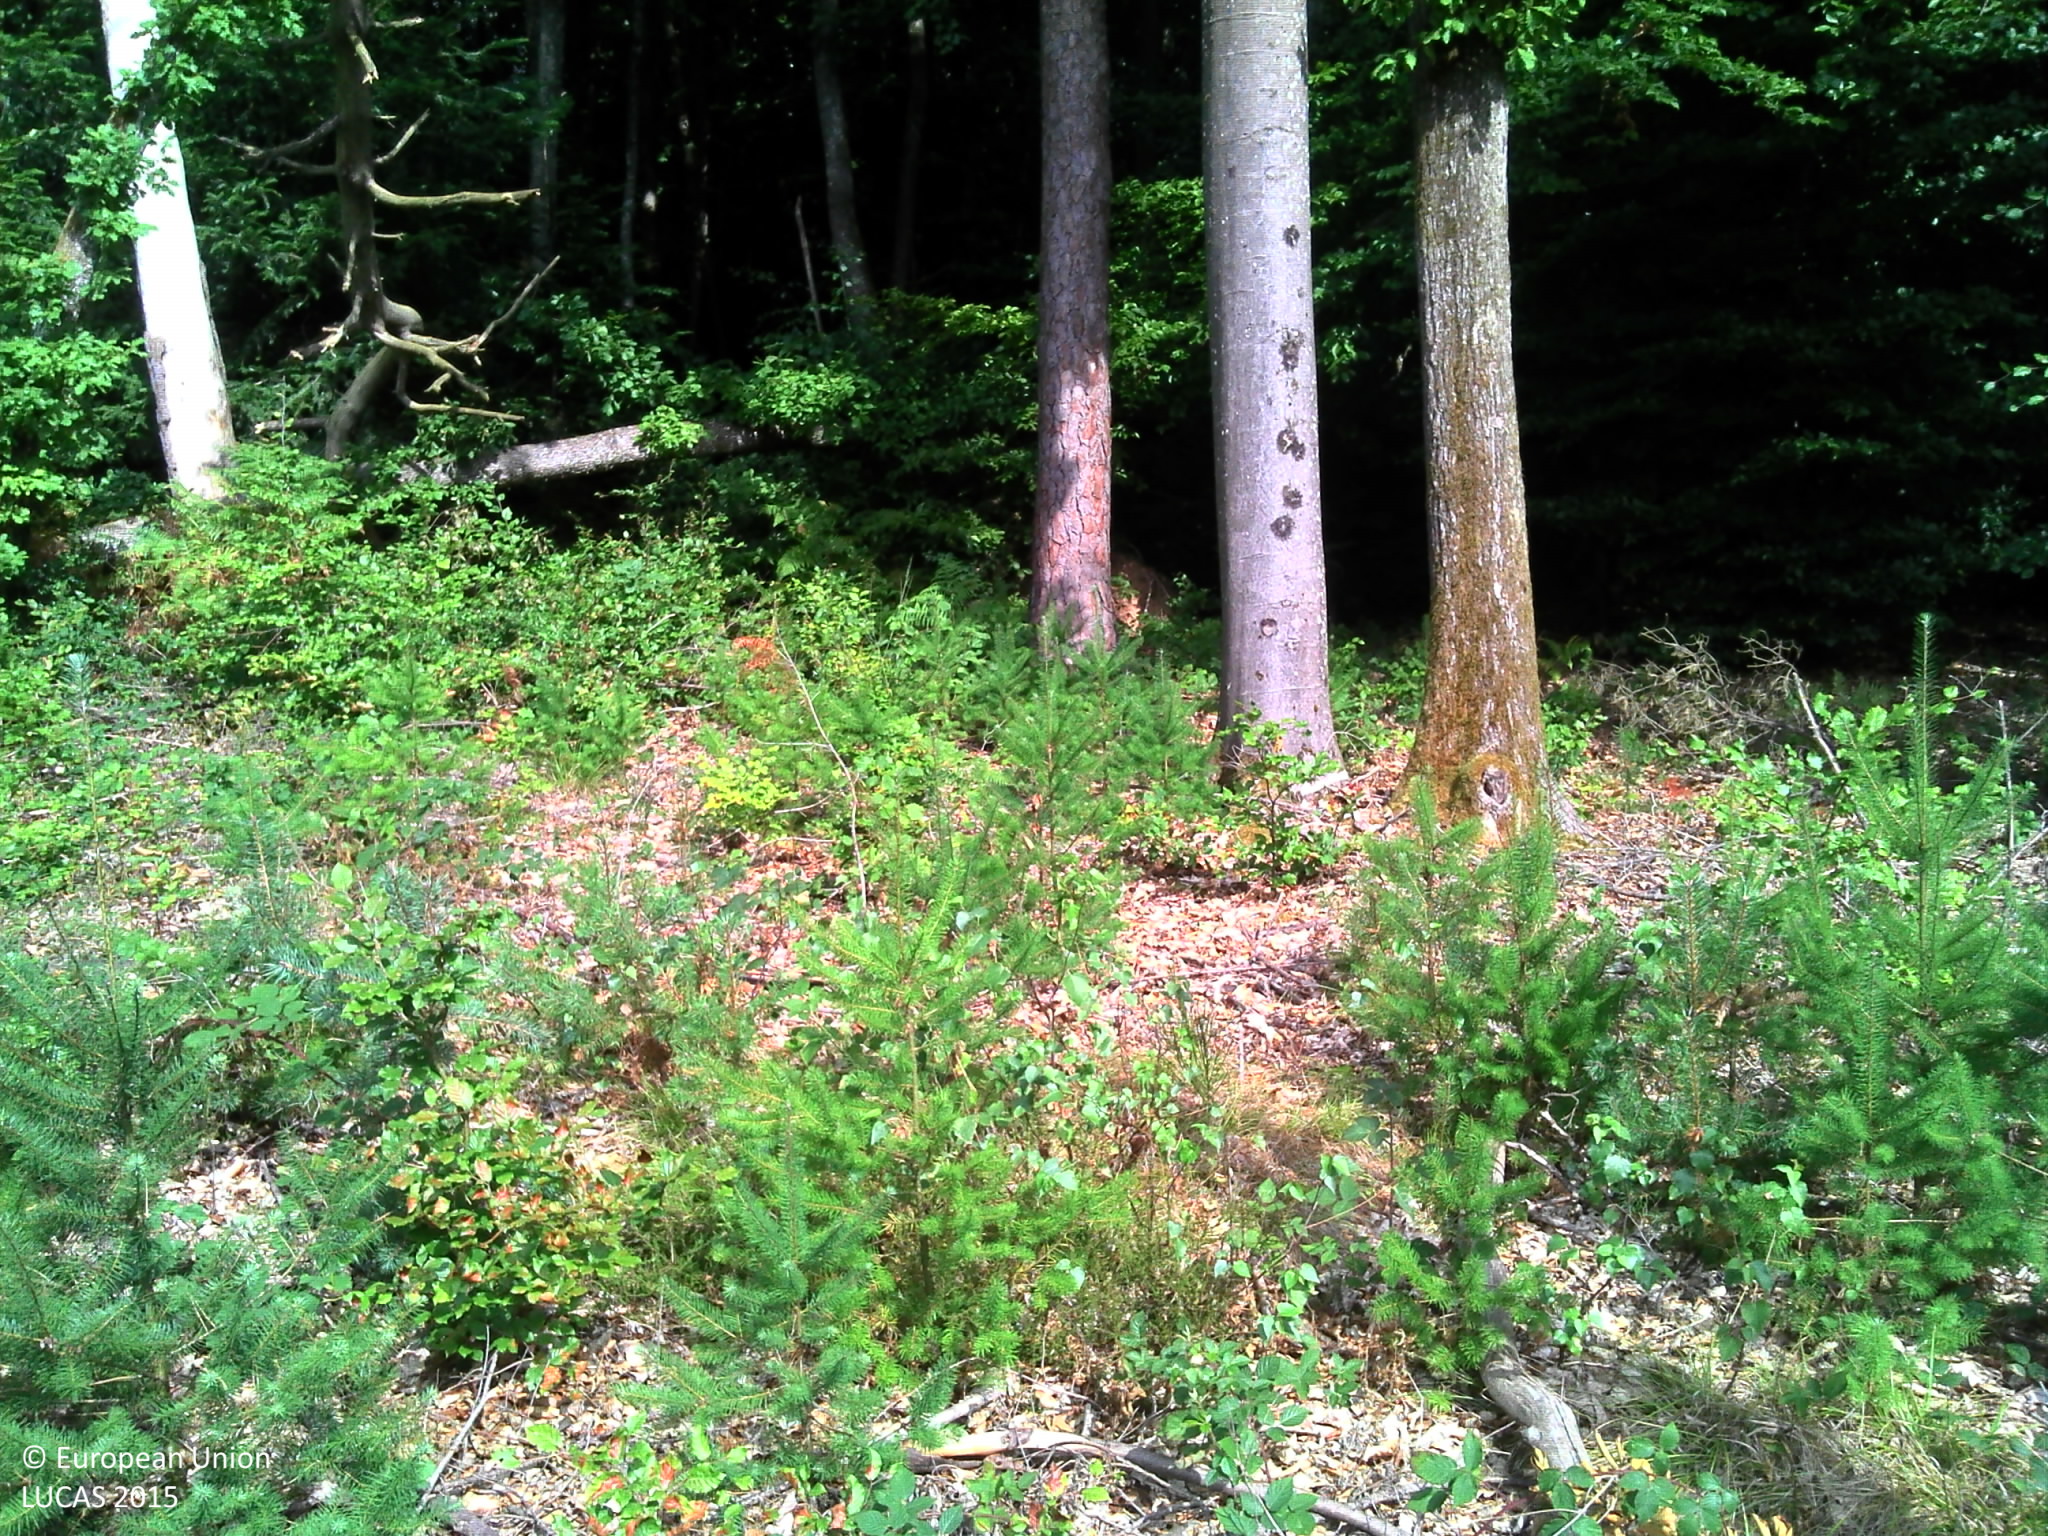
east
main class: Shrubland
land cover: Shrubland without tree cover
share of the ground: > 75 %
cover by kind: shrubs 80 %, herbaceous plants 20 %
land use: Forestry
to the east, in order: Shrubland without tree cover; Broadleaved woodland; Spruce dominated mixed woodland; Shrubland without tree cover; Spruce dominated mixed woodland; Spruce dominated coniferous woodland; Fences; Grassland without tree/shrub cover
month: August
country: FR
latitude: 46.2951
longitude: 4.4066
